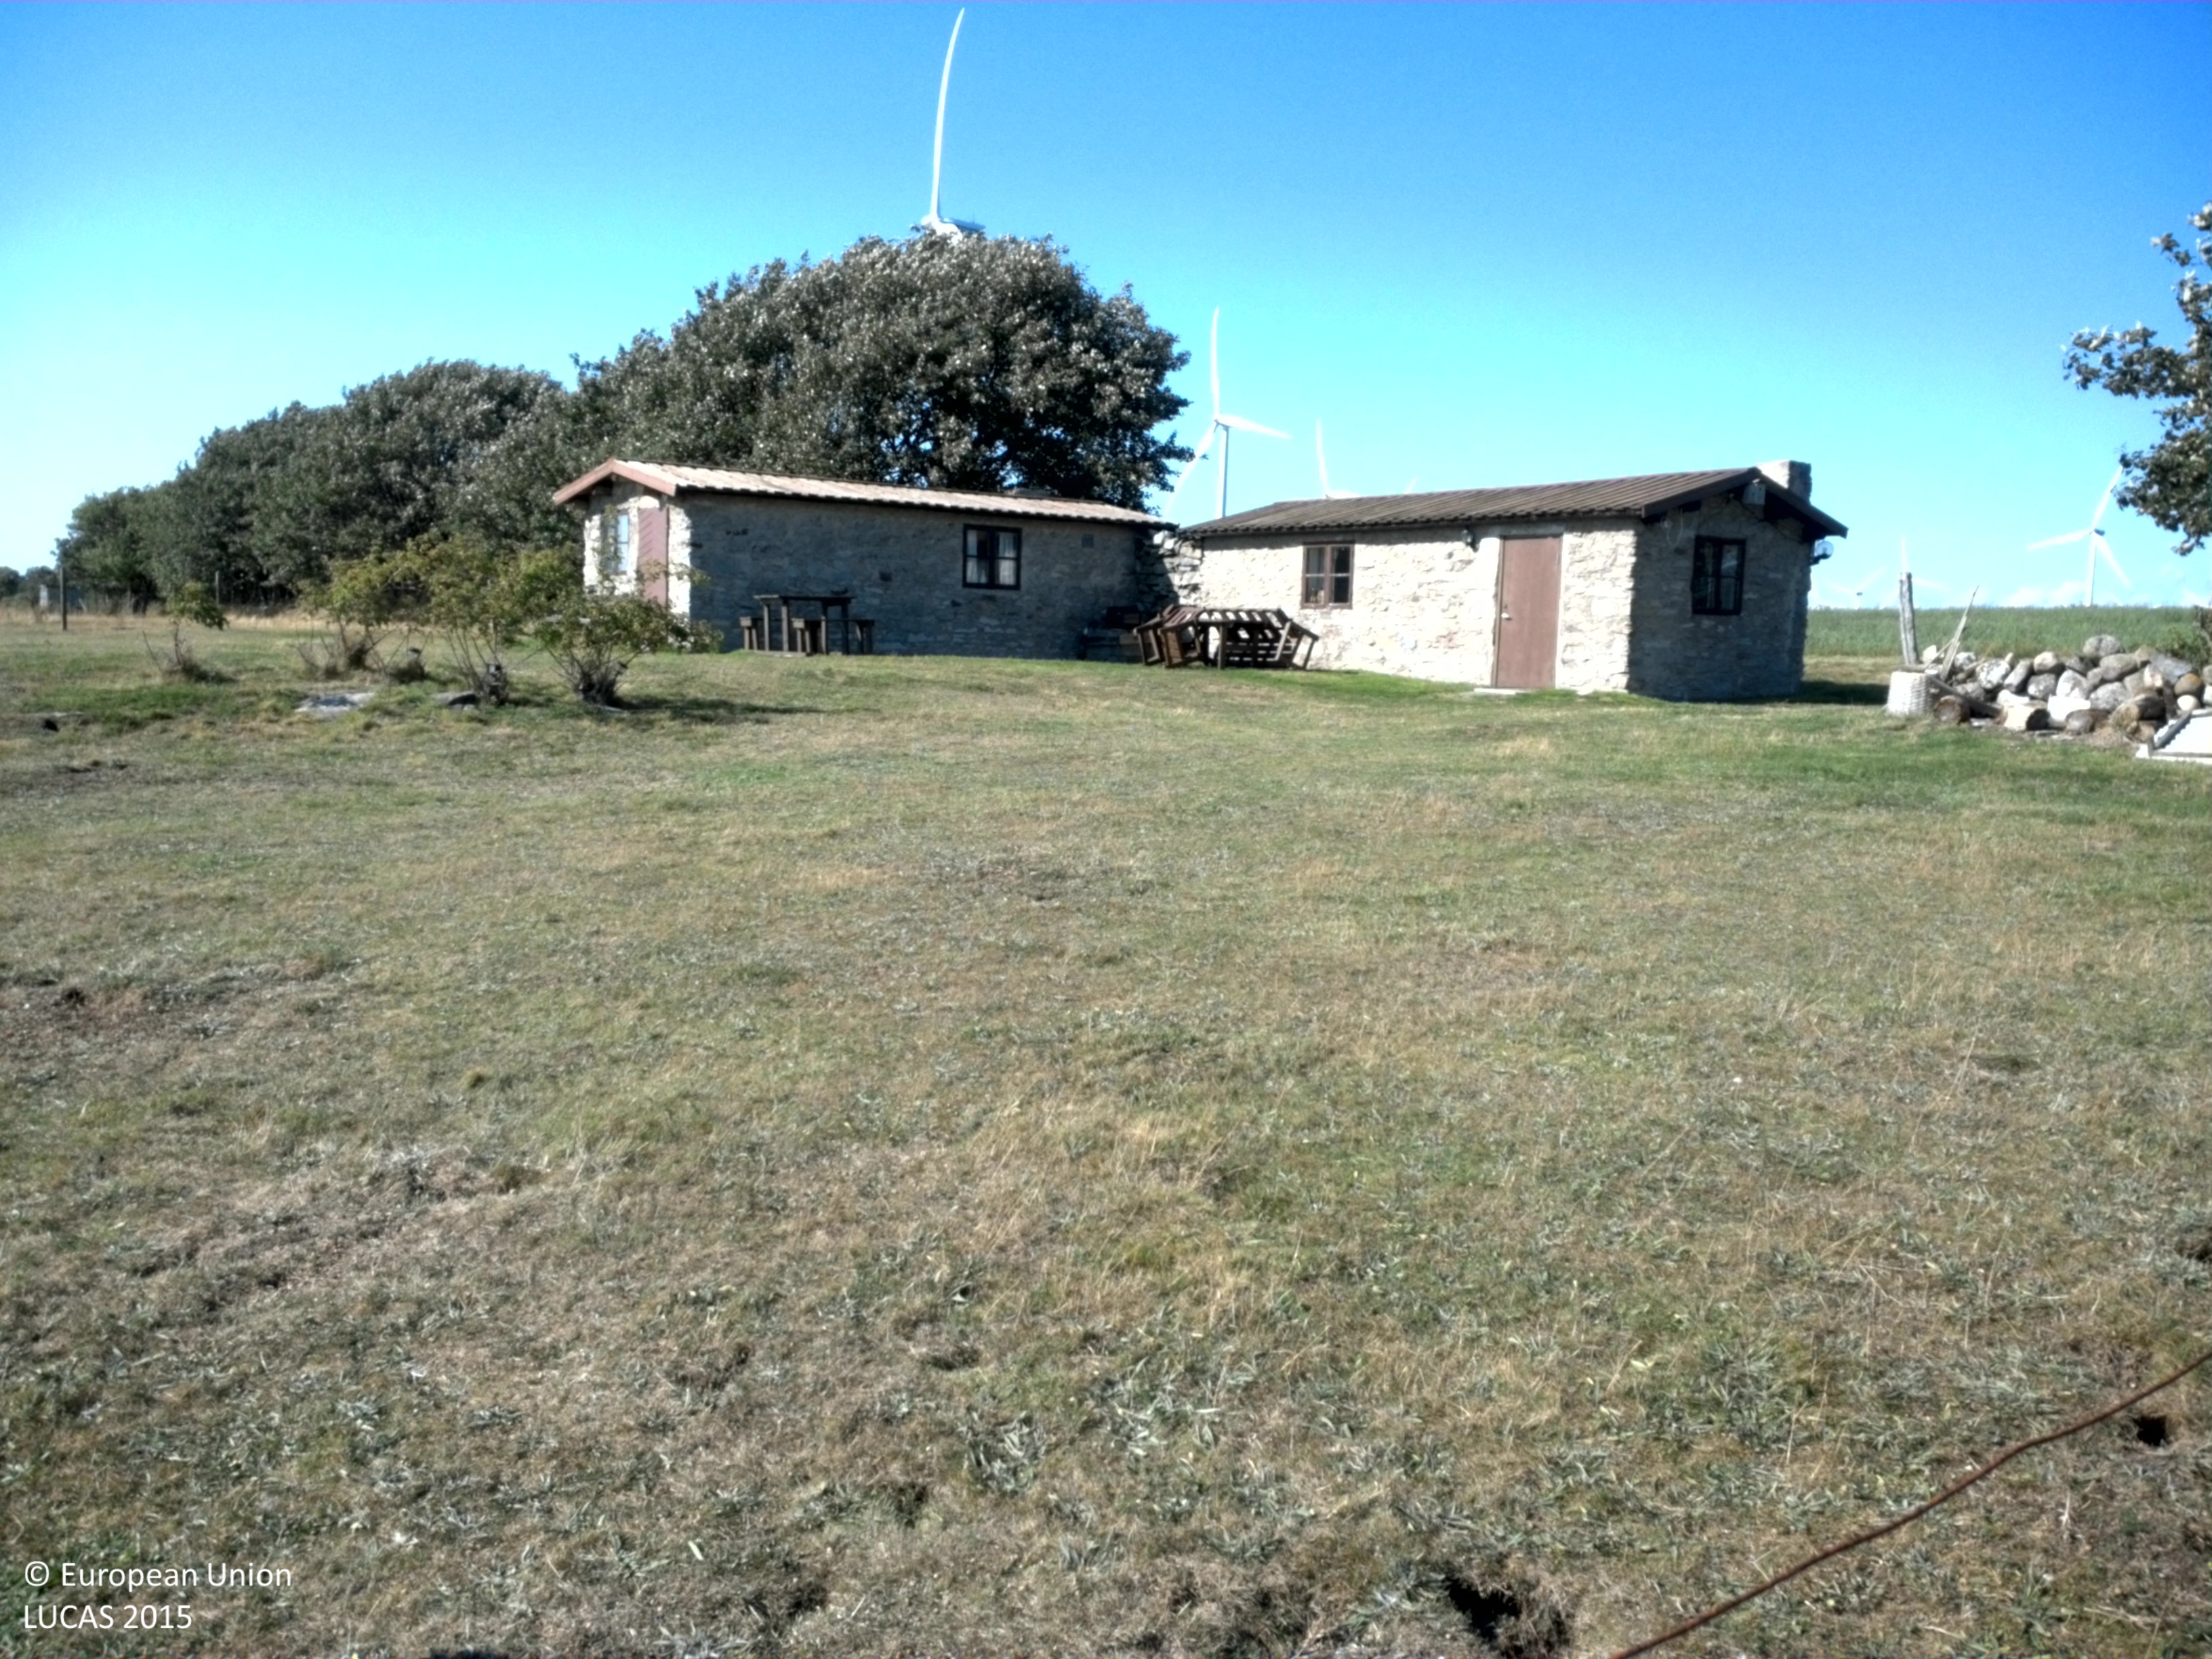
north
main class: Grassland
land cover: Grassland without tree/shrub cover
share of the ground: > 75 %
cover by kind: herbaceous plants 100 %
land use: Agriculture (excluding fallow land and kitchen gardens)
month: July
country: SE
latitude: 57.0641
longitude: 18.2043
